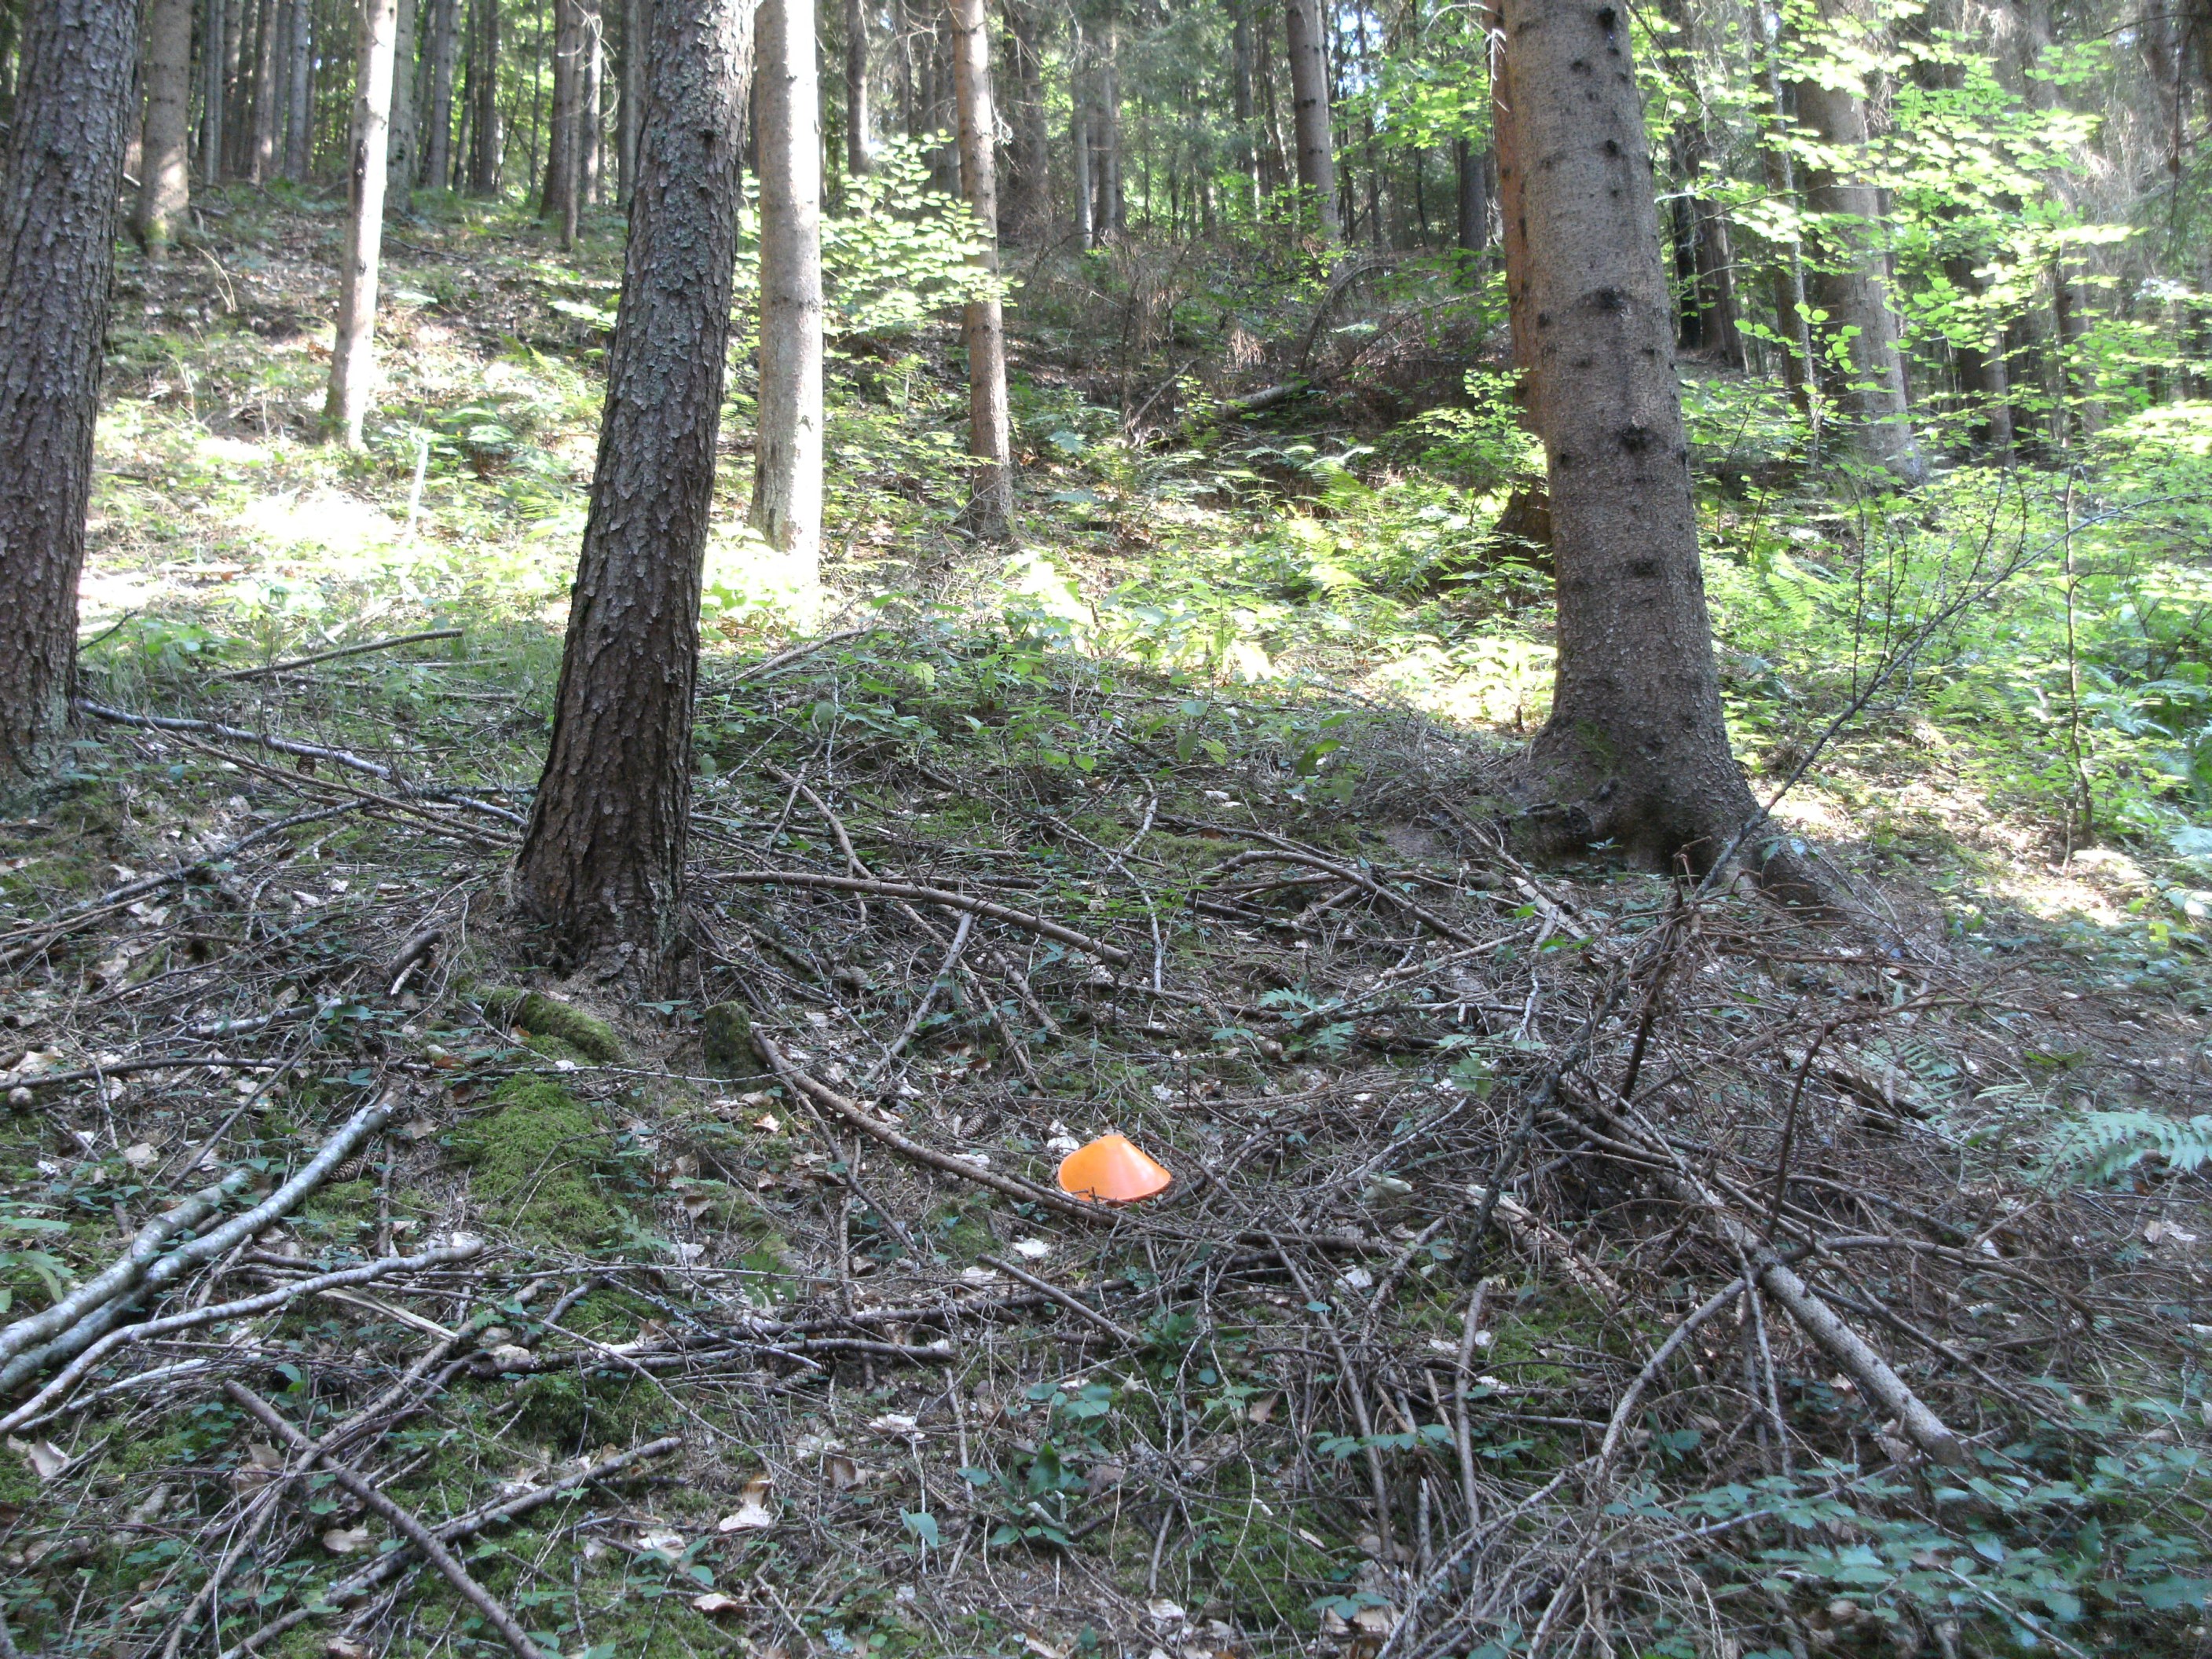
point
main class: Woodland
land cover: Spruce dominated coniferous woodland
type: hemiboreal forest and nemoral coniferous forest and mixed broadleaved-coniferous forest
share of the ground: > 75 %
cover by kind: coniferous forest trees 70 %, broadleaved forest trees 10 %, shrubs 5 %, herbaceous plants 5 %, lichens and mosses 5 %, unconsolidated bare surface 5 %
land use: Forestry
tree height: > 5 m
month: July
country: AT
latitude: 46.5475
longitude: 14.4446
